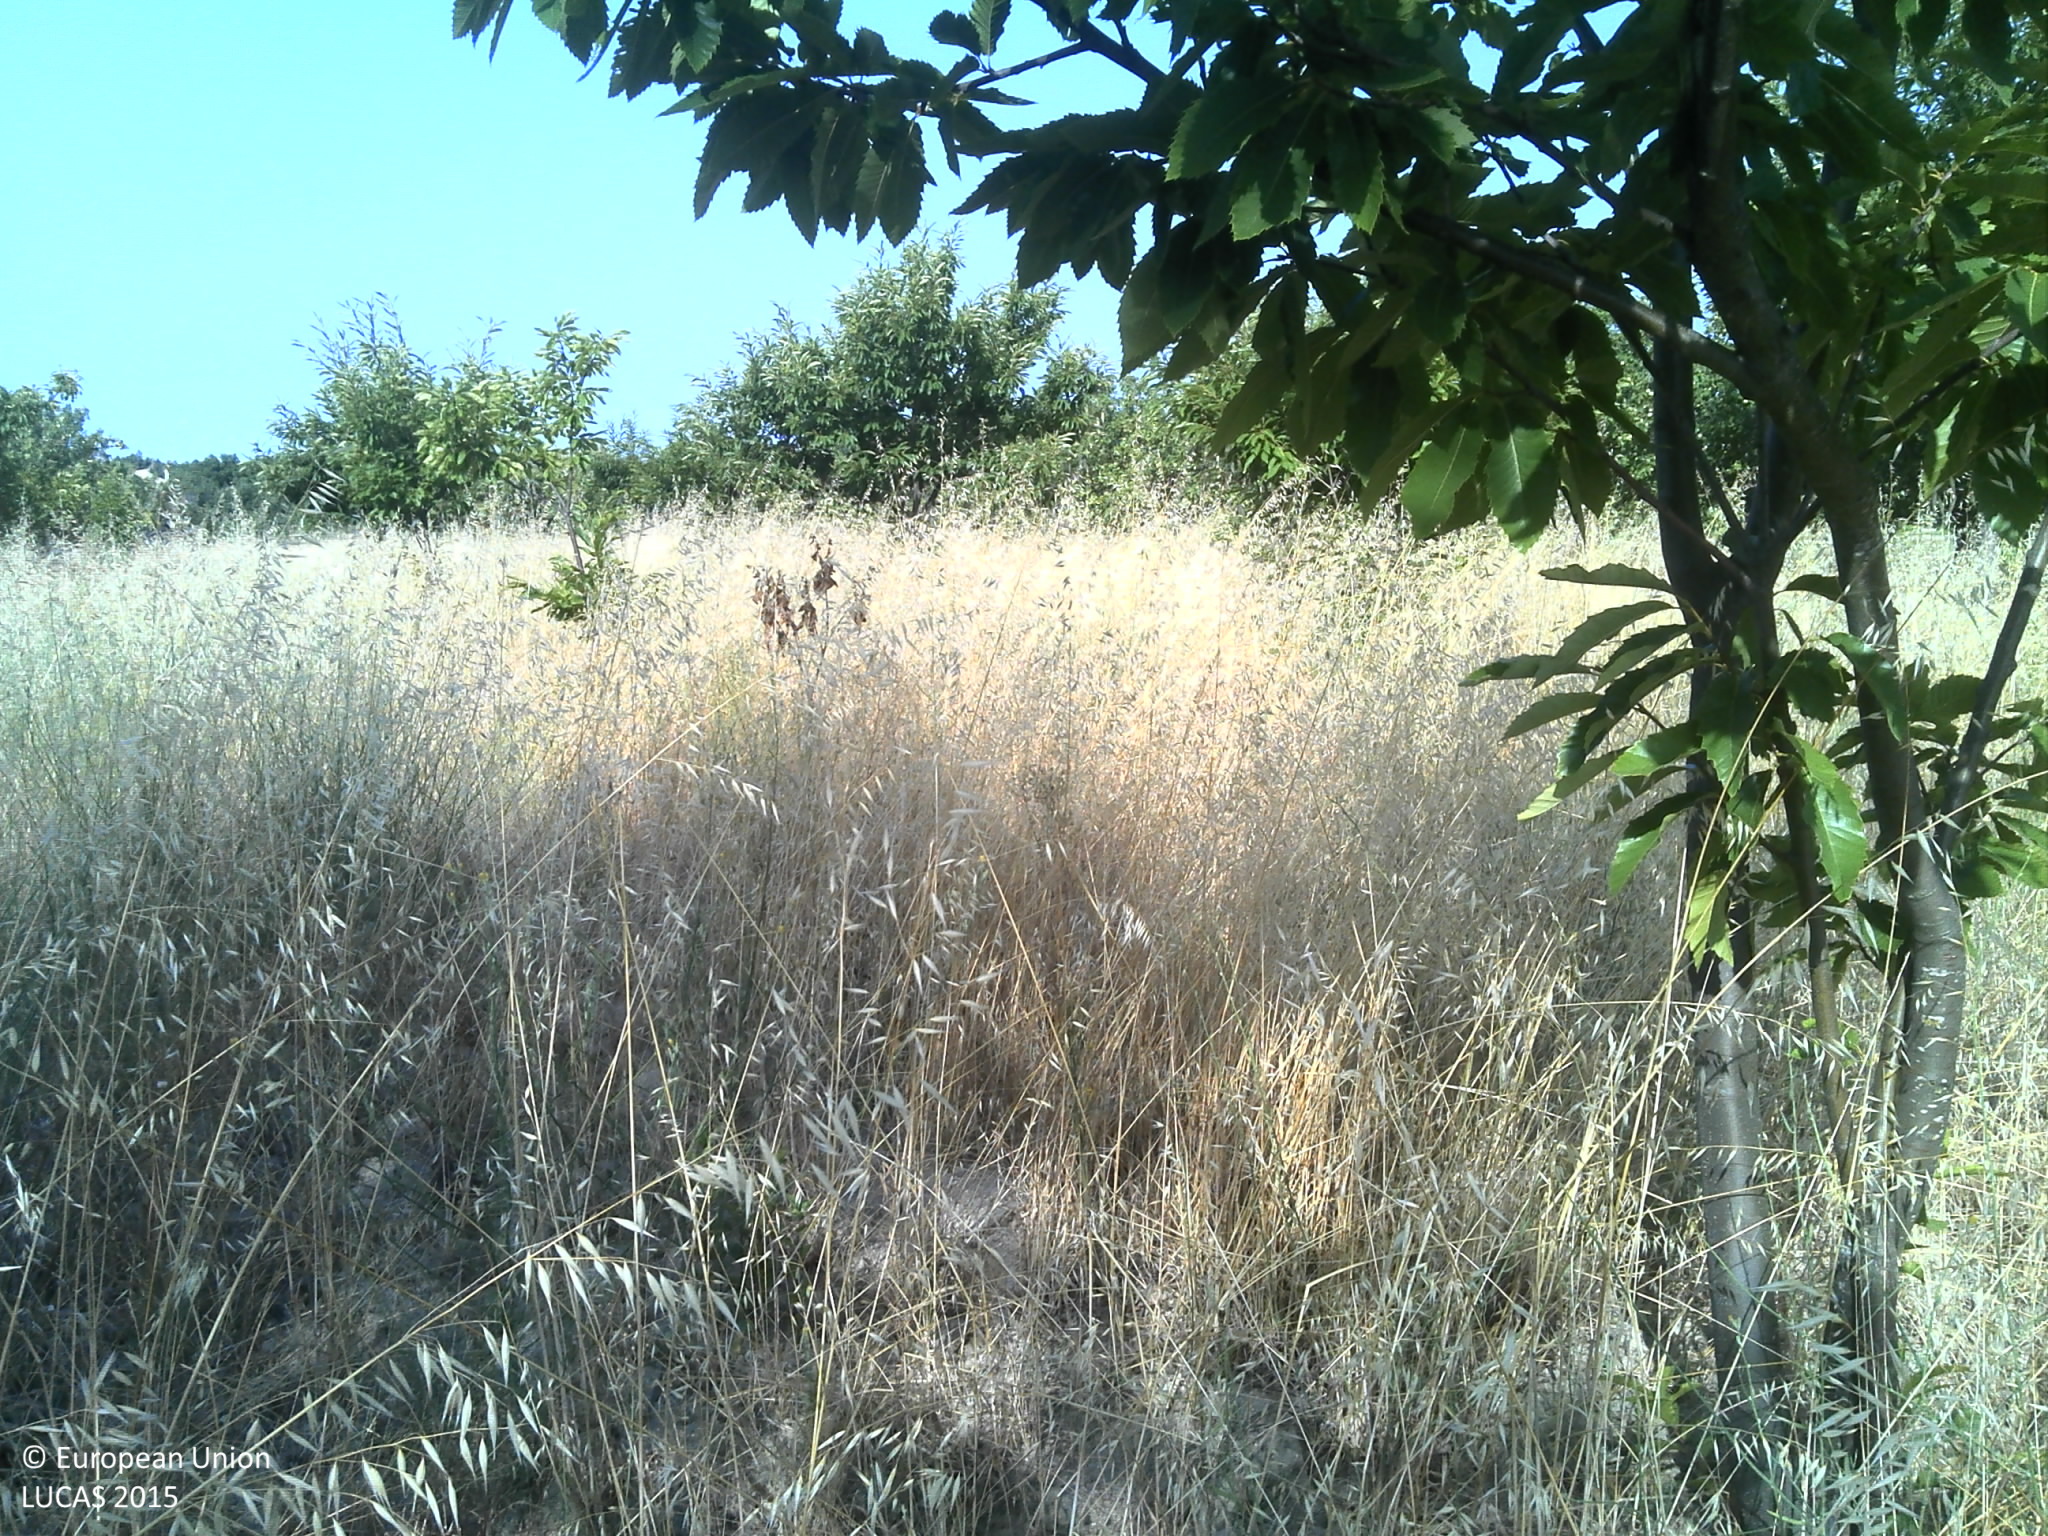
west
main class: Cropland
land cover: Nuts trees
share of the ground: < 10 %
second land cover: Spontaneously vegetated surfaces
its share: 50 - 75 %
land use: Agriculture (excluding fallow land and kitchen gardens)
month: July
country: PT
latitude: 40.9456
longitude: -7.4238
